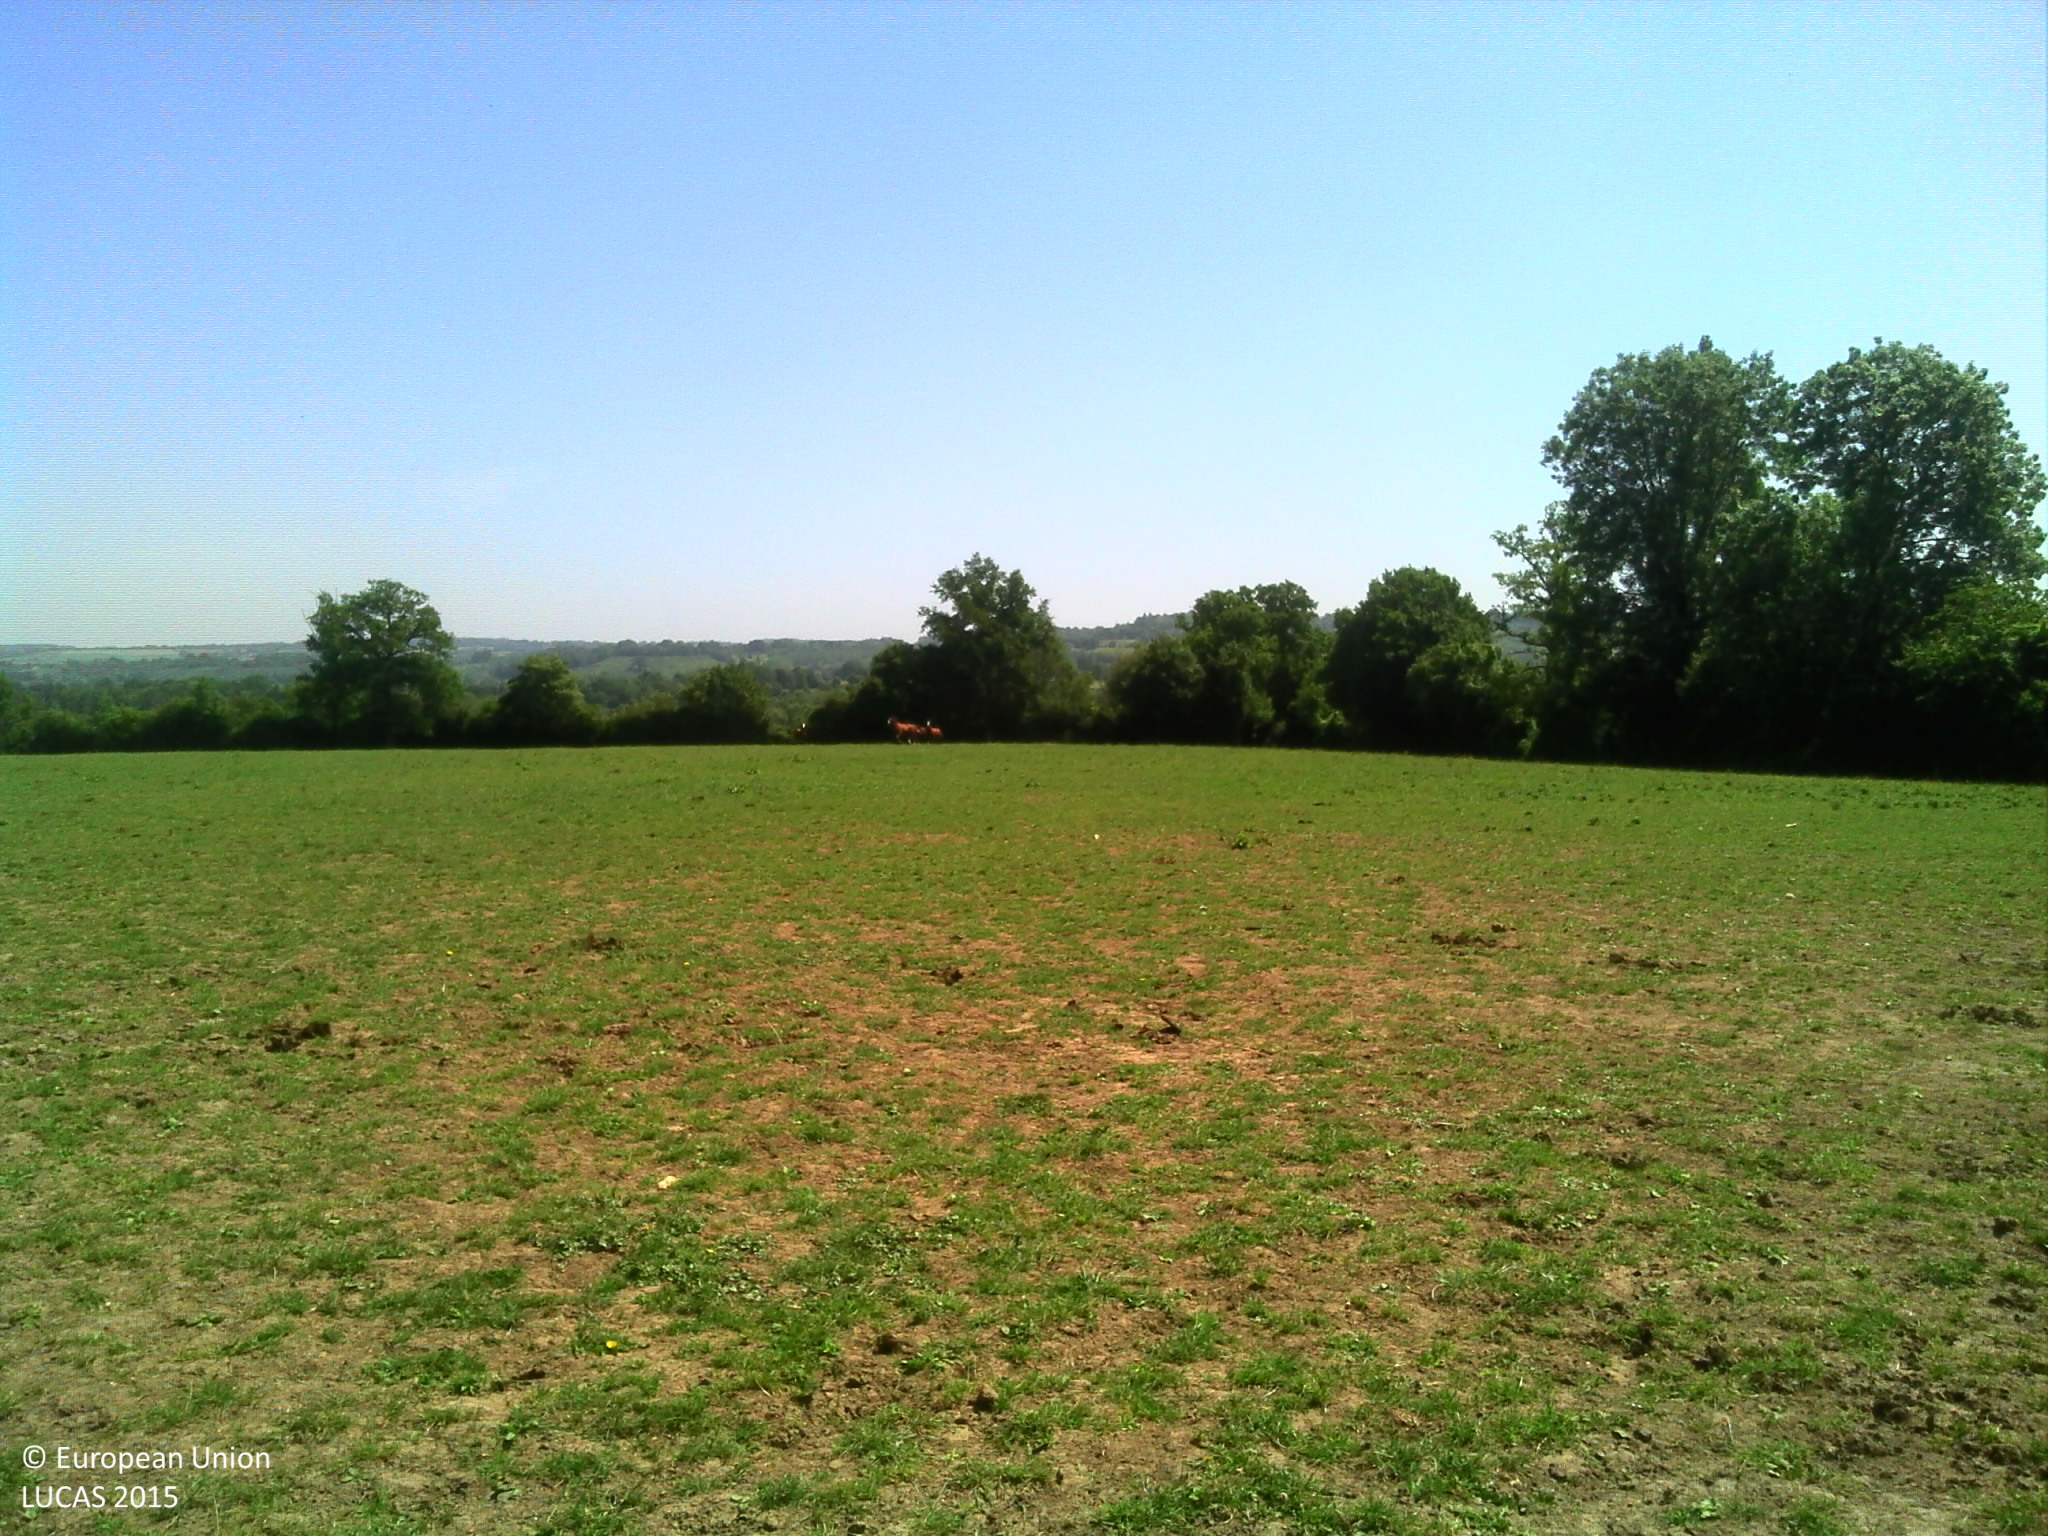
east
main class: Grassland
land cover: Grassland without tree/shrub cover
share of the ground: 50 - 75 %
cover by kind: herbaceous plants 85 %, unconsolidated bare surface 15 %
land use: Agriculture (excluding fallow land and kitchen gardens)
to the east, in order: Grassland without tree/shrub cover; Sand; Broadleaved woodland; Grassland without tree/shrub cover; Broadleaved woodland; Grassland without tree/shrub cover
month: June
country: FR
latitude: 48.7589
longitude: 0.1360
